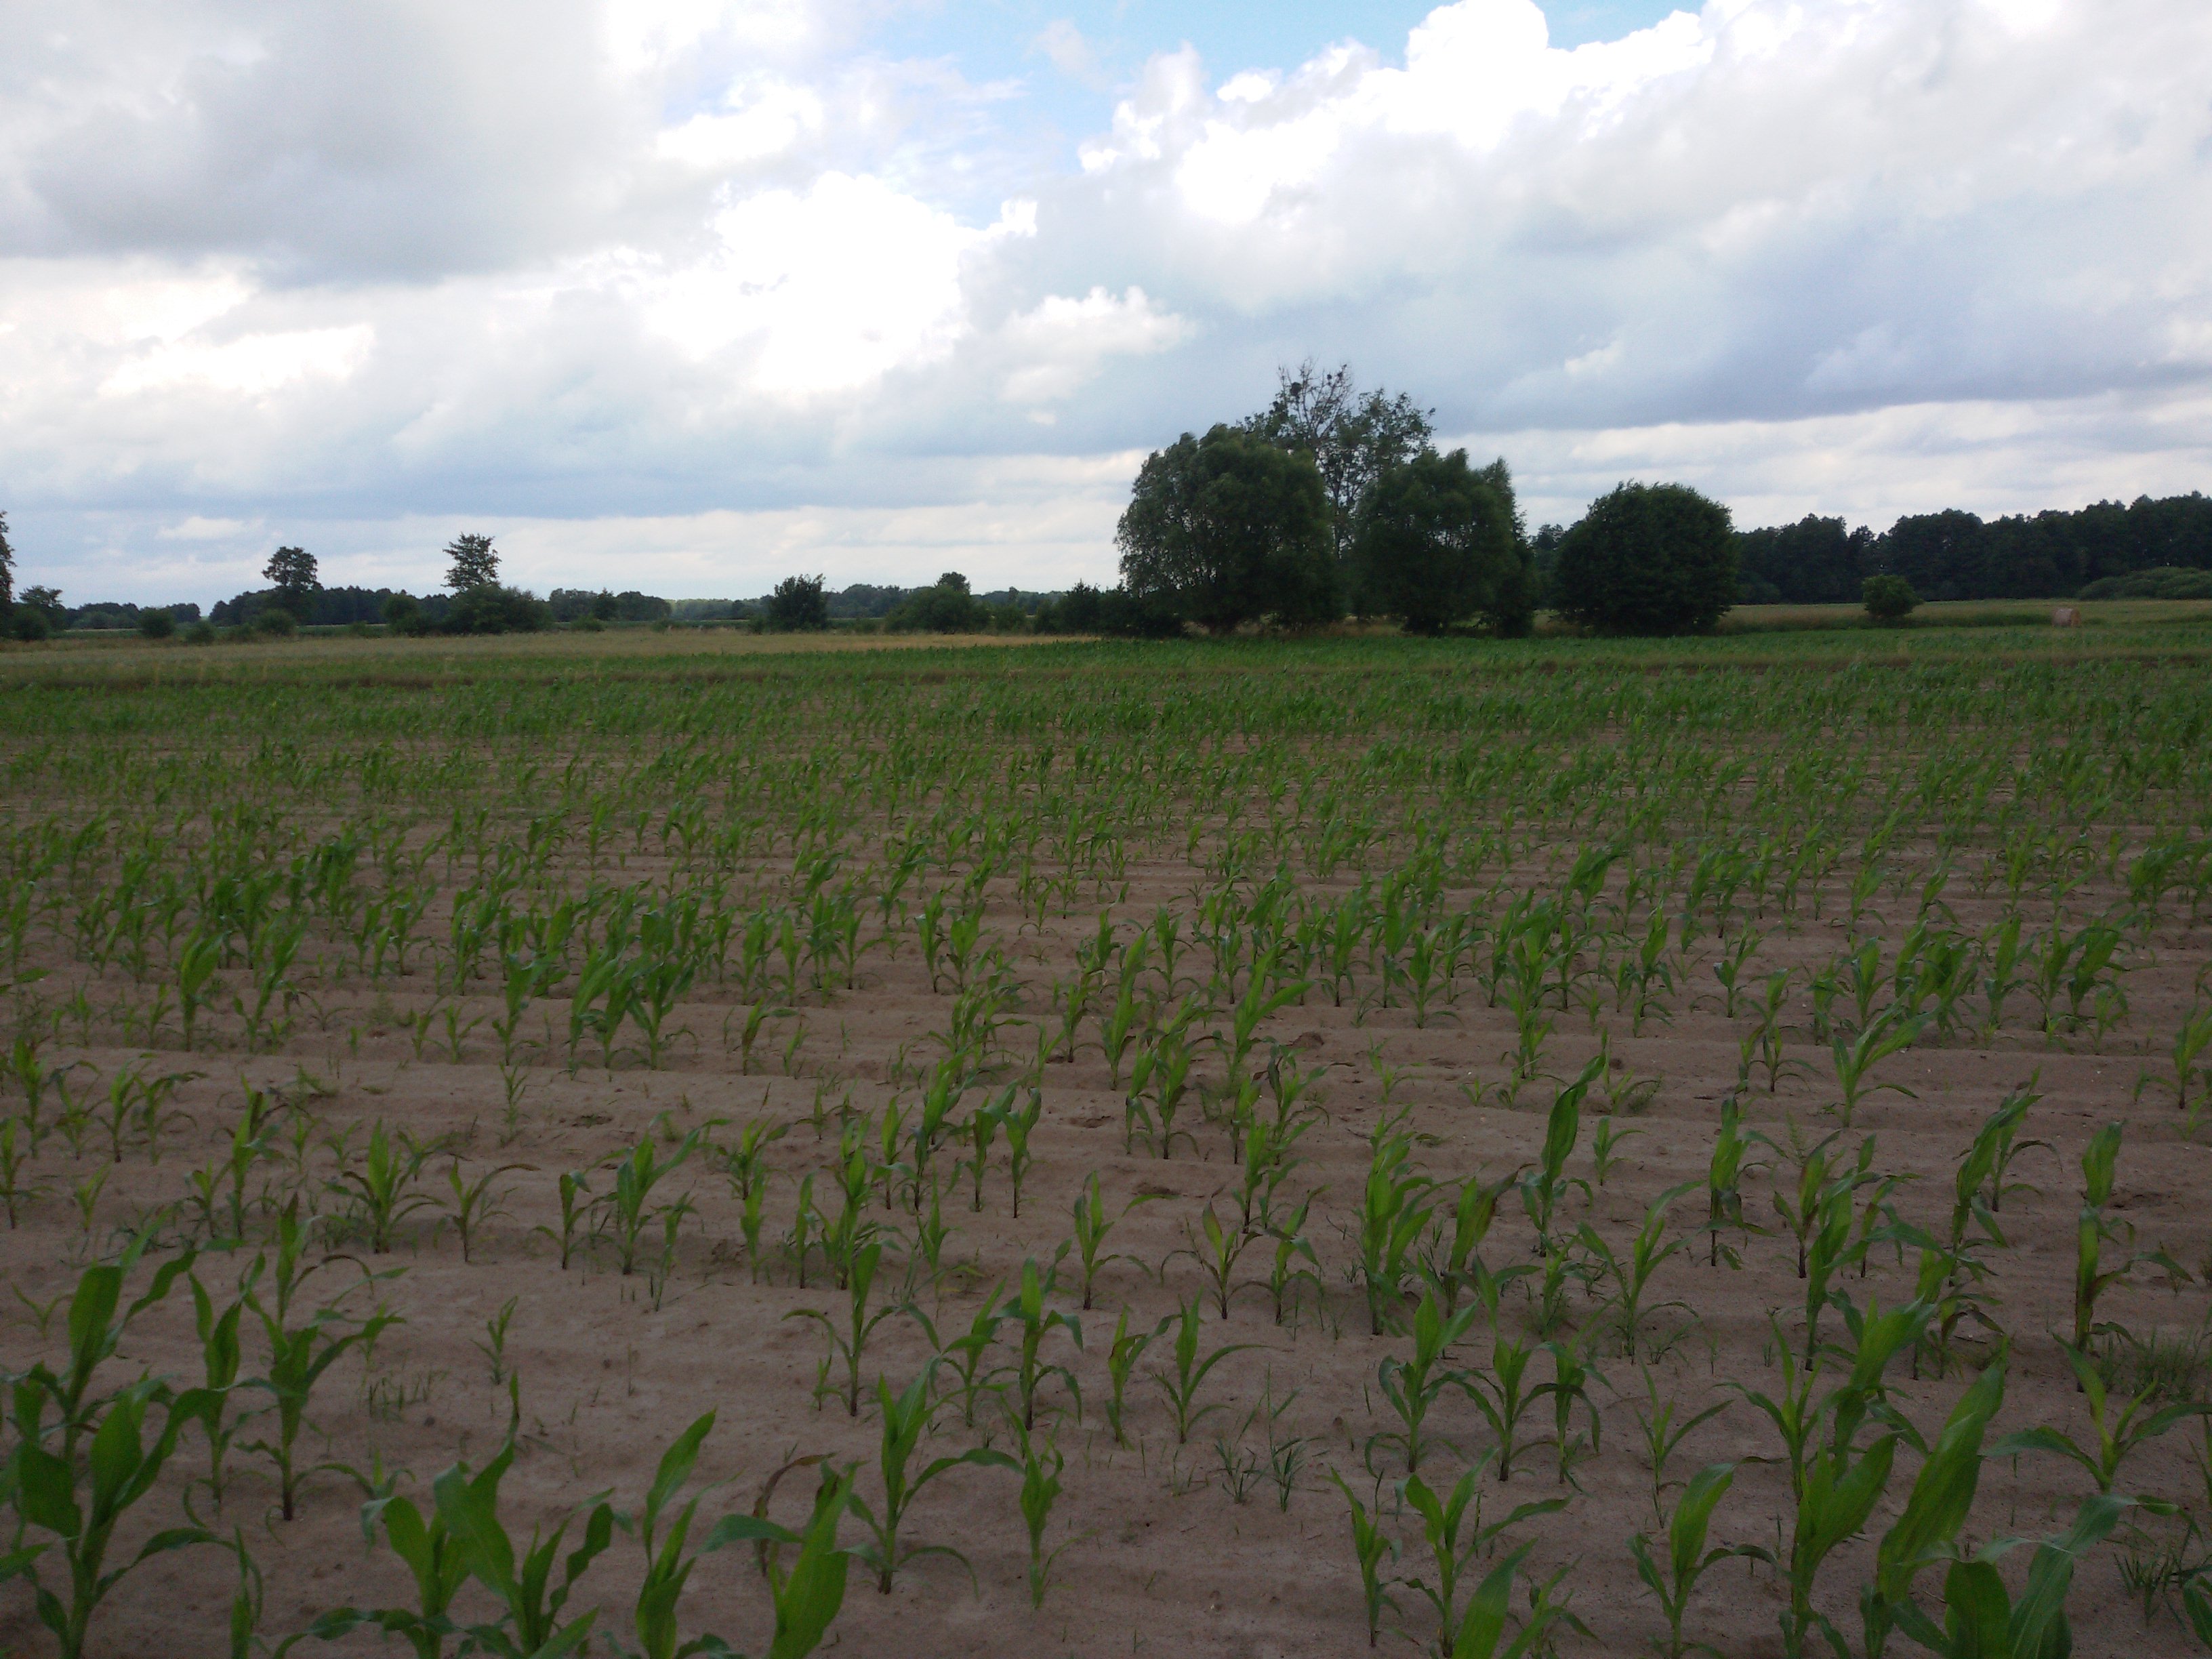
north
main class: Cropland
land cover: Maize
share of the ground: 25 - 50 %
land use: Agriculture (excluding fallow land and kitchen gardens)
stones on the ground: < 10 %
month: July
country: PL
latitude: 52.9612
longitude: 17.6502
